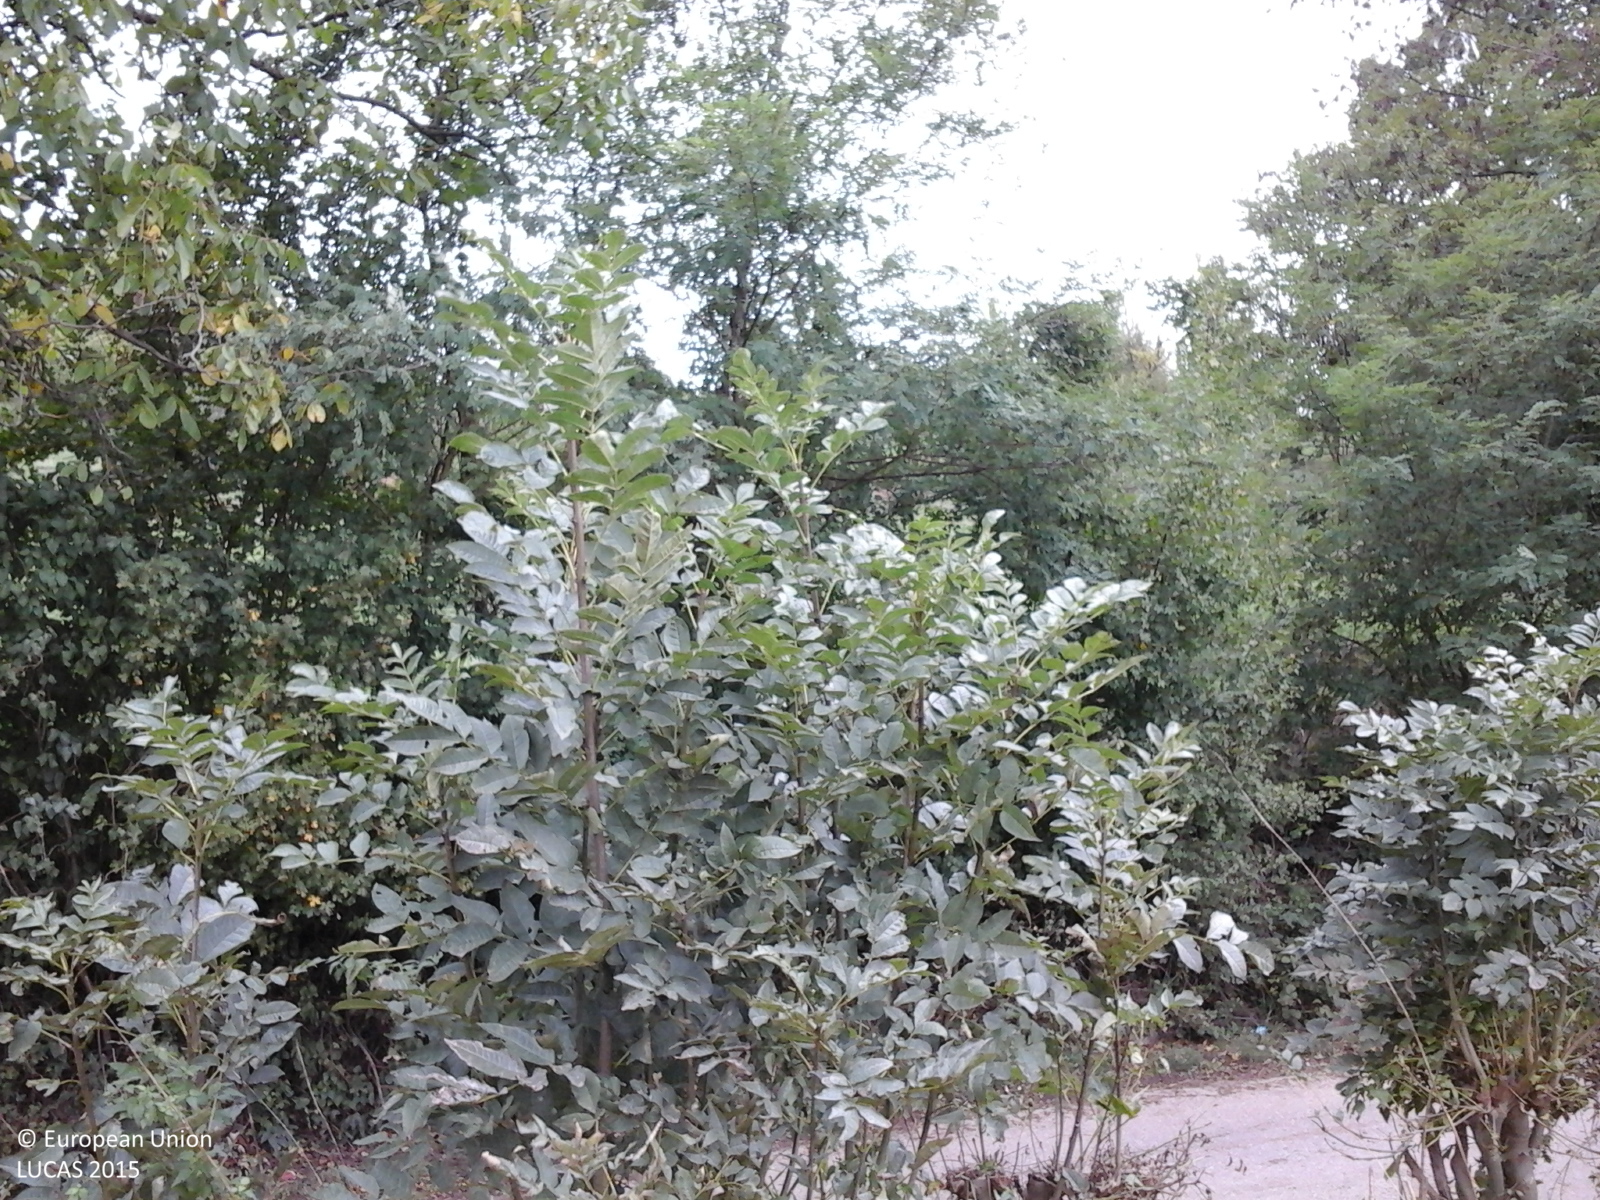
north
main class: Cropland
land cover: Maize
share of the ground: < 10 %
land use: Agriculture (excluding fallow land and kitchen gardens)
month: September
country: RO
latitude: 45.9555
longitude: 22.9966
